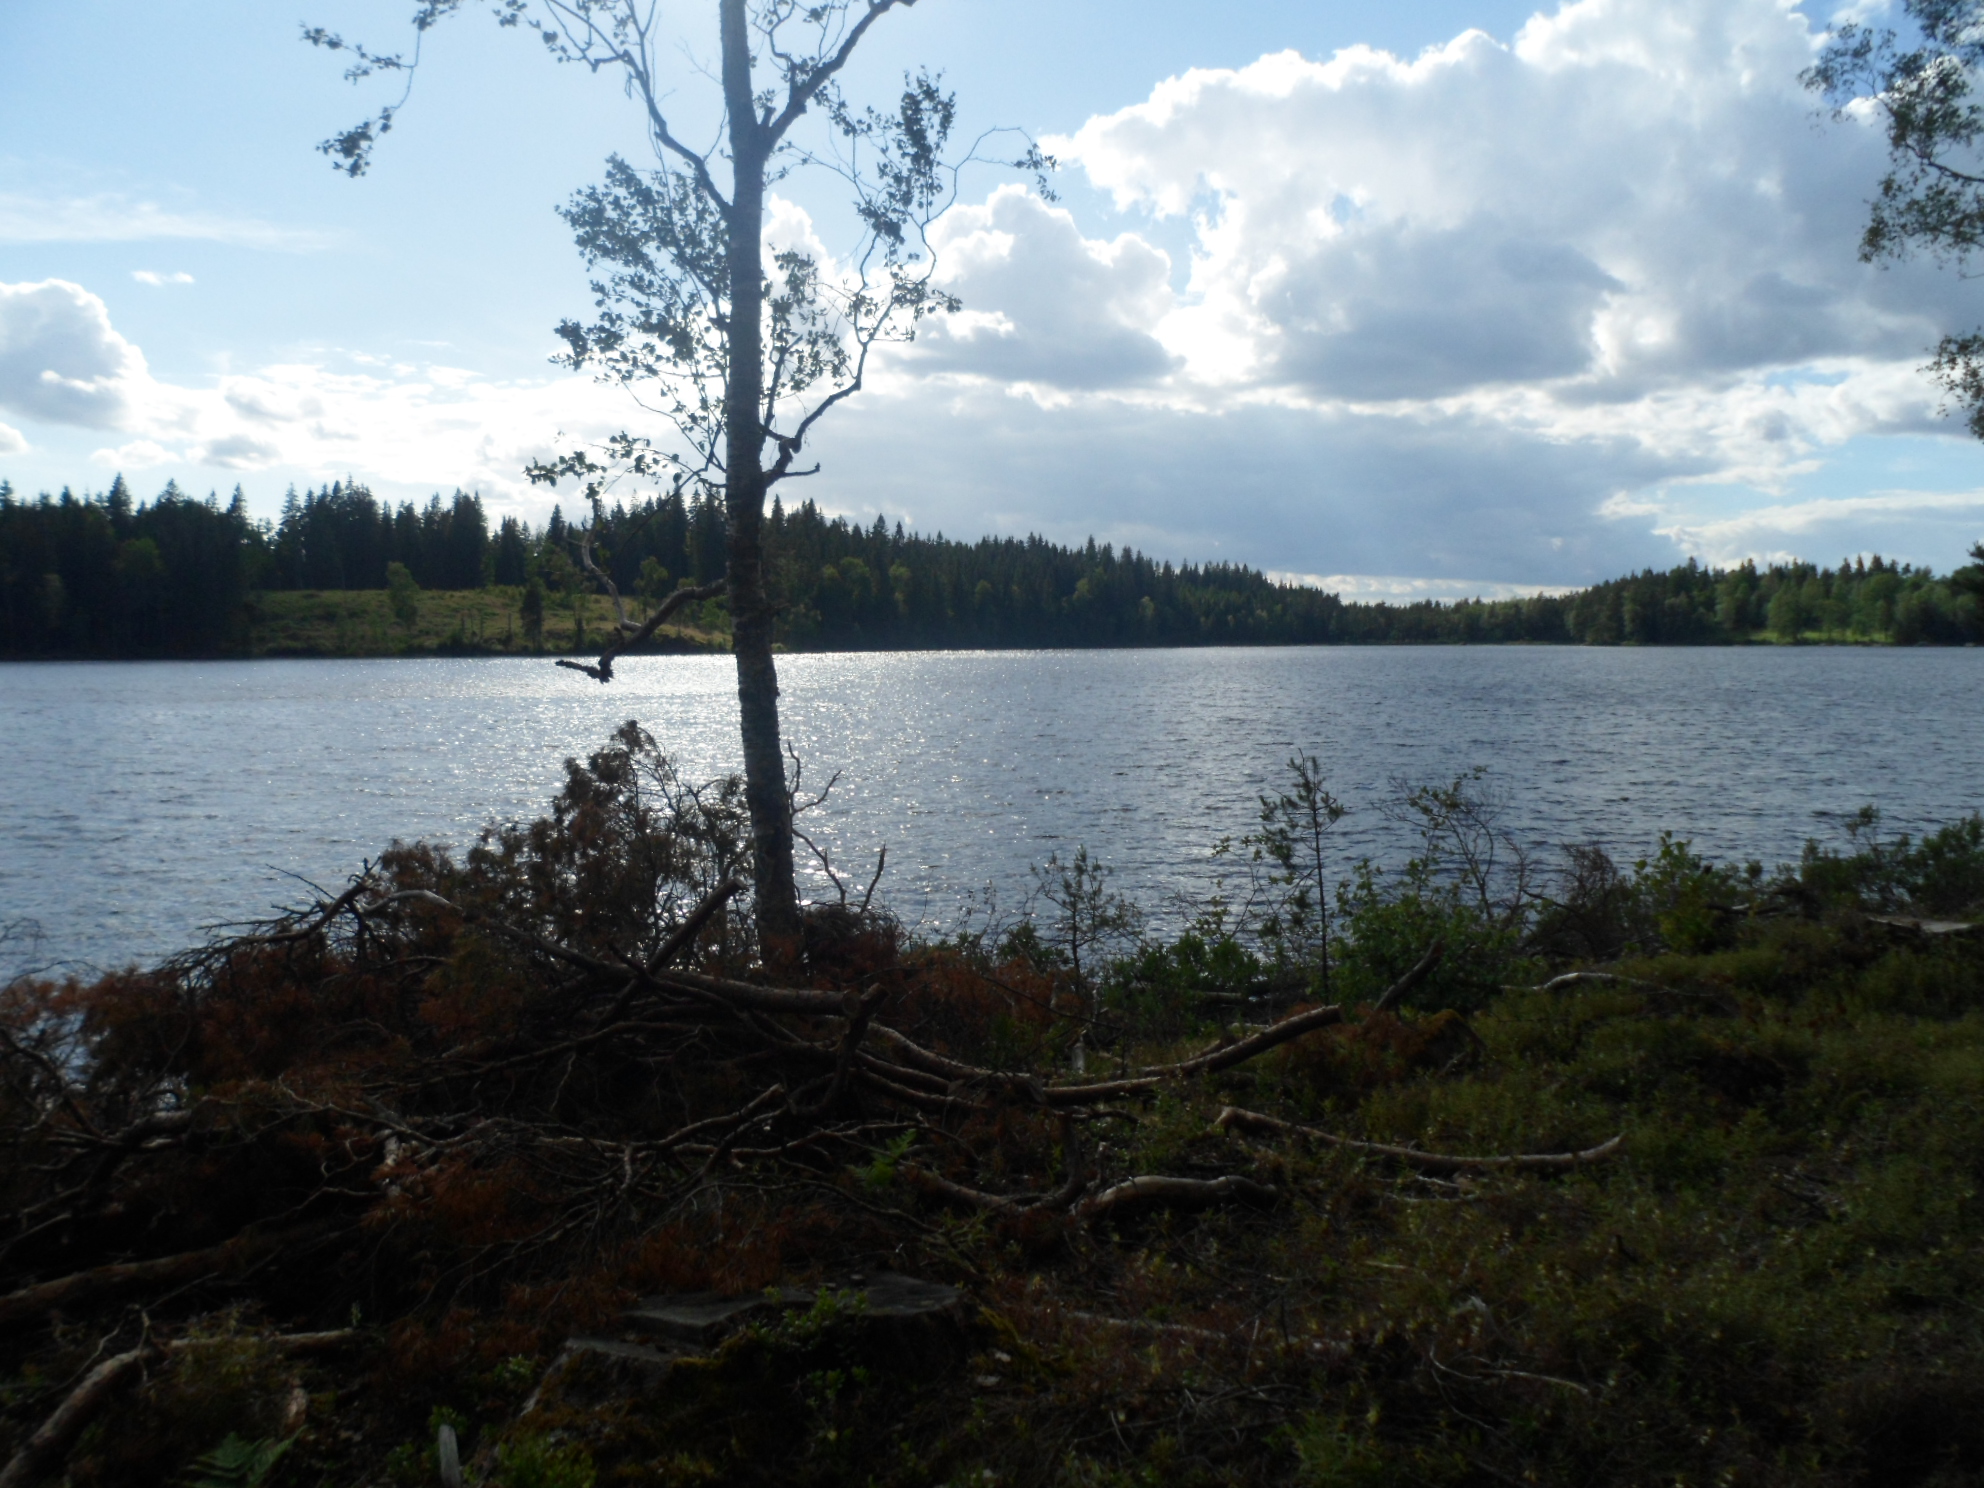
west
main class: Woodland
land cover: Spruce dominated coniferous woodland
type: boreal forest
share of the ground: 25 - 50 %
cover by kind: coniferous forest trees 30 %, shrubs 30 %, herbaceous plants 20 %, lichens and mosses 10 %, broadleaved forest trees 5 %, consolidated bare surface 5 %
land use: Forestry
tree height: > 5 m
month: June
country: SE
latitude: 57.1833
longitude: 14.6784
